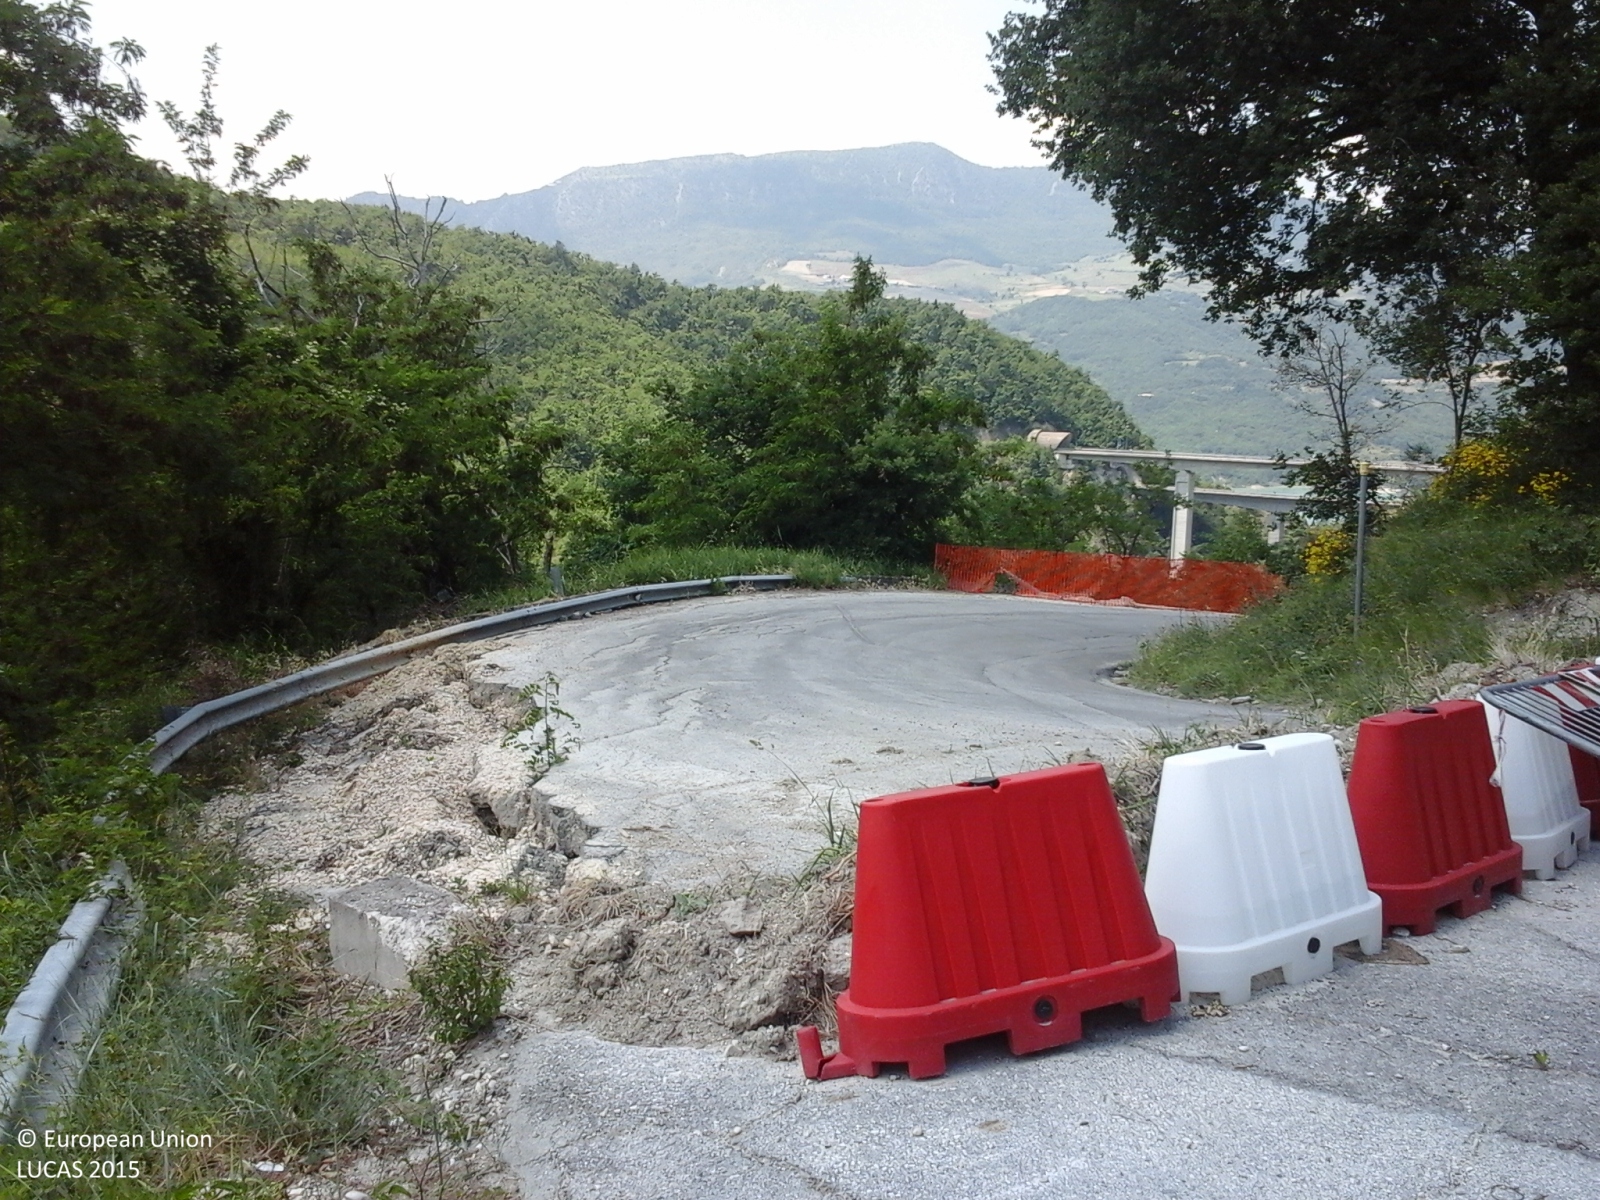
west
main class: Grassland
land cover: Grassland without tree/shrub cover
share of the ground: > 75 %
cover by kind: herbaceous plants 100 %
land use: Agriculture (excluding fallow land and kitchen gardens)
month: June
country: IT
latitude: 41.9800
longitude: 14.3910
